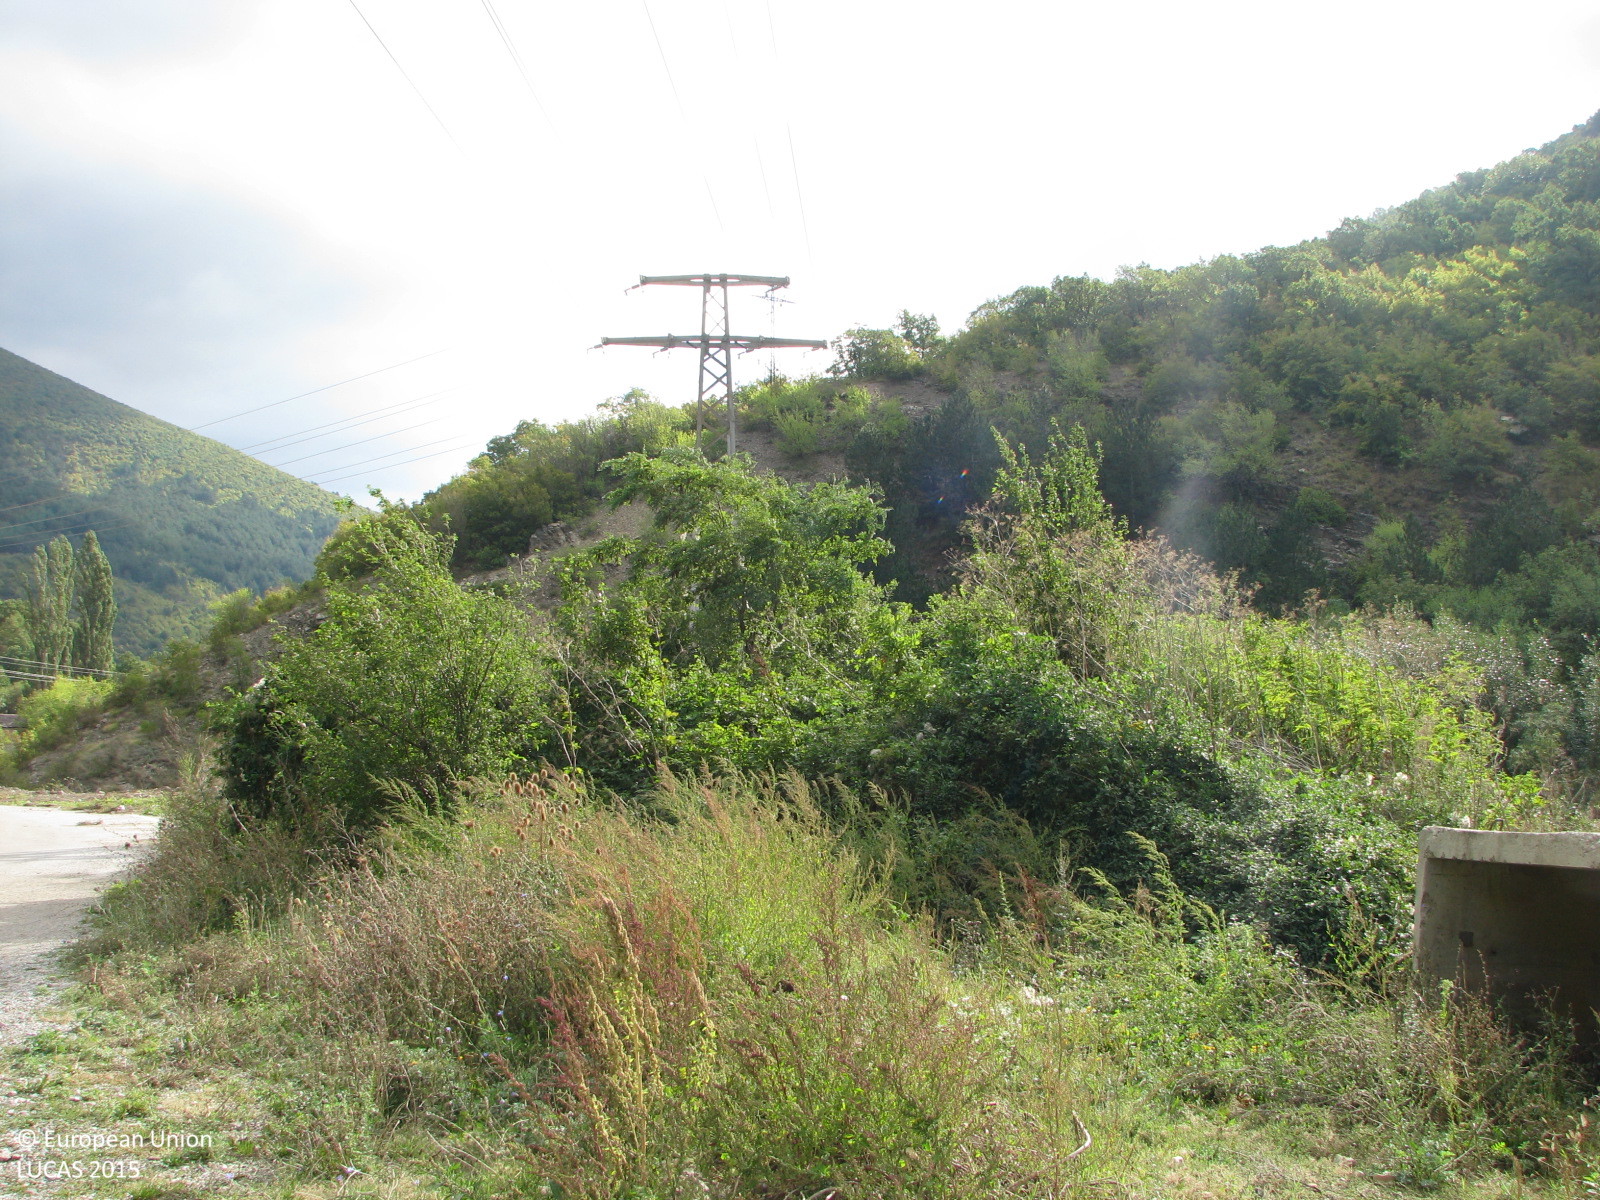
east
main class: Woodland
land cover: Broadleaved woodland
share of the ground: > 75 %
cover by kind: broadleaved forest trees 100 %
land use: Forestry
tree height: < 5 m
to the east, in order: Broadleaved woodland
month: September
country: BG
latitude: 42.6860
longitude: 26.2854
